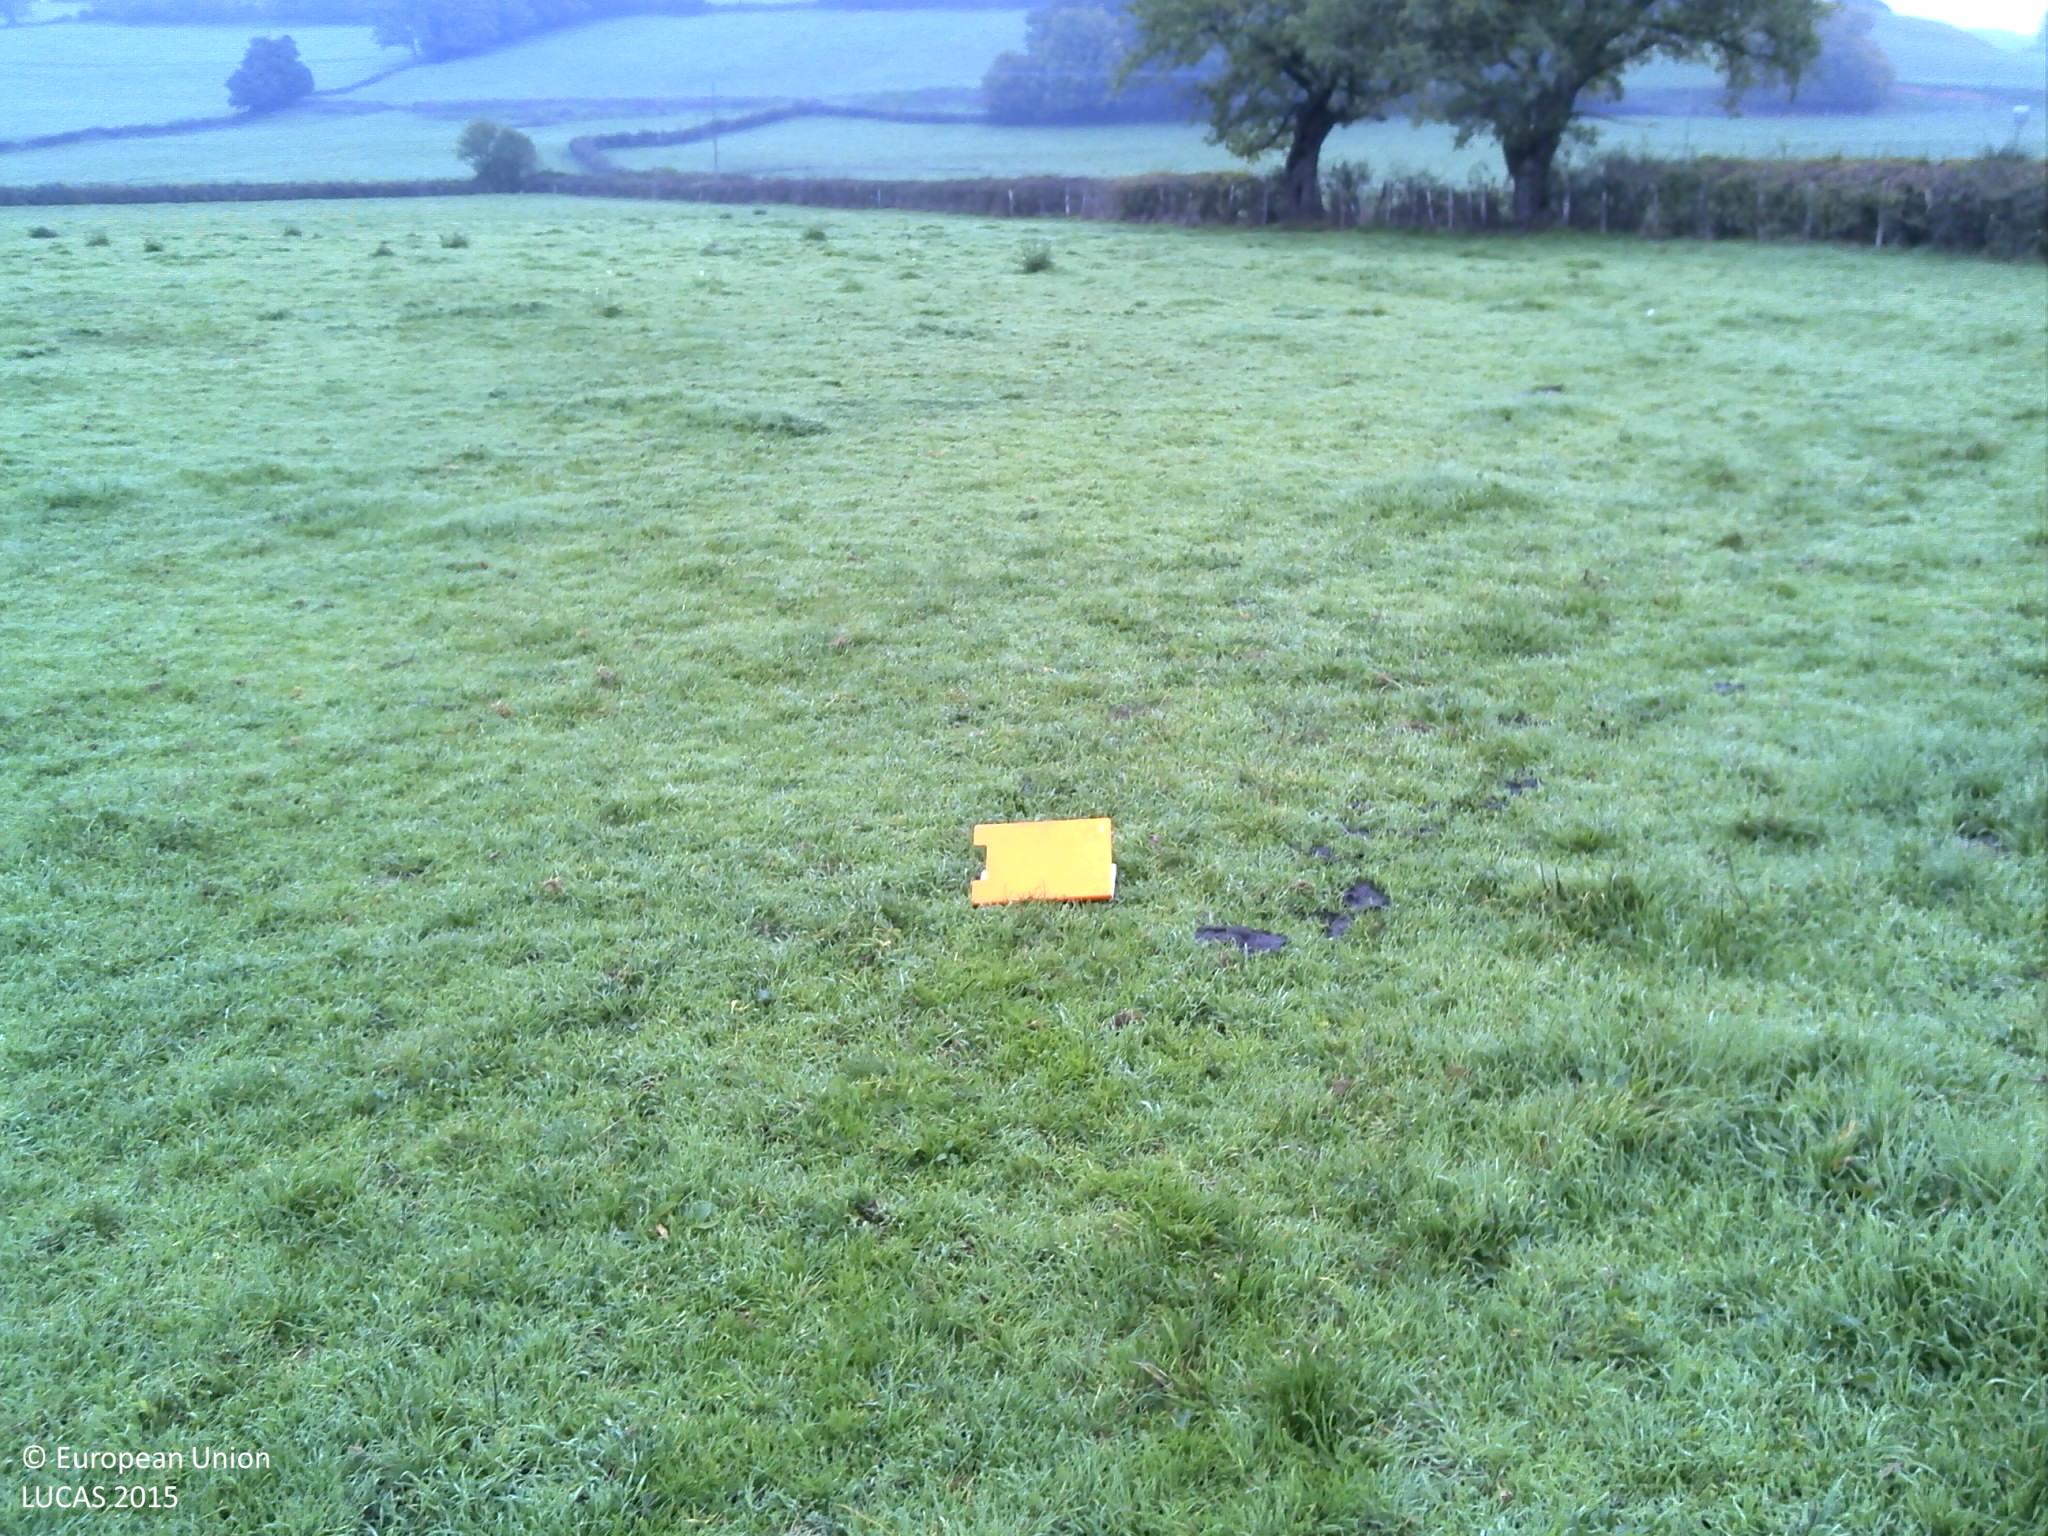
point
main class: Grassland
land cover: Grassland without tree/shrub cover
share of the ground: > 75 %
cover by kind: herbaceous plants 100 %
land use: Agriculture (excluding fallow land and kitchen gardens)
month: October
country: FR
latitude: 46.5282
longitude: 4.0424
